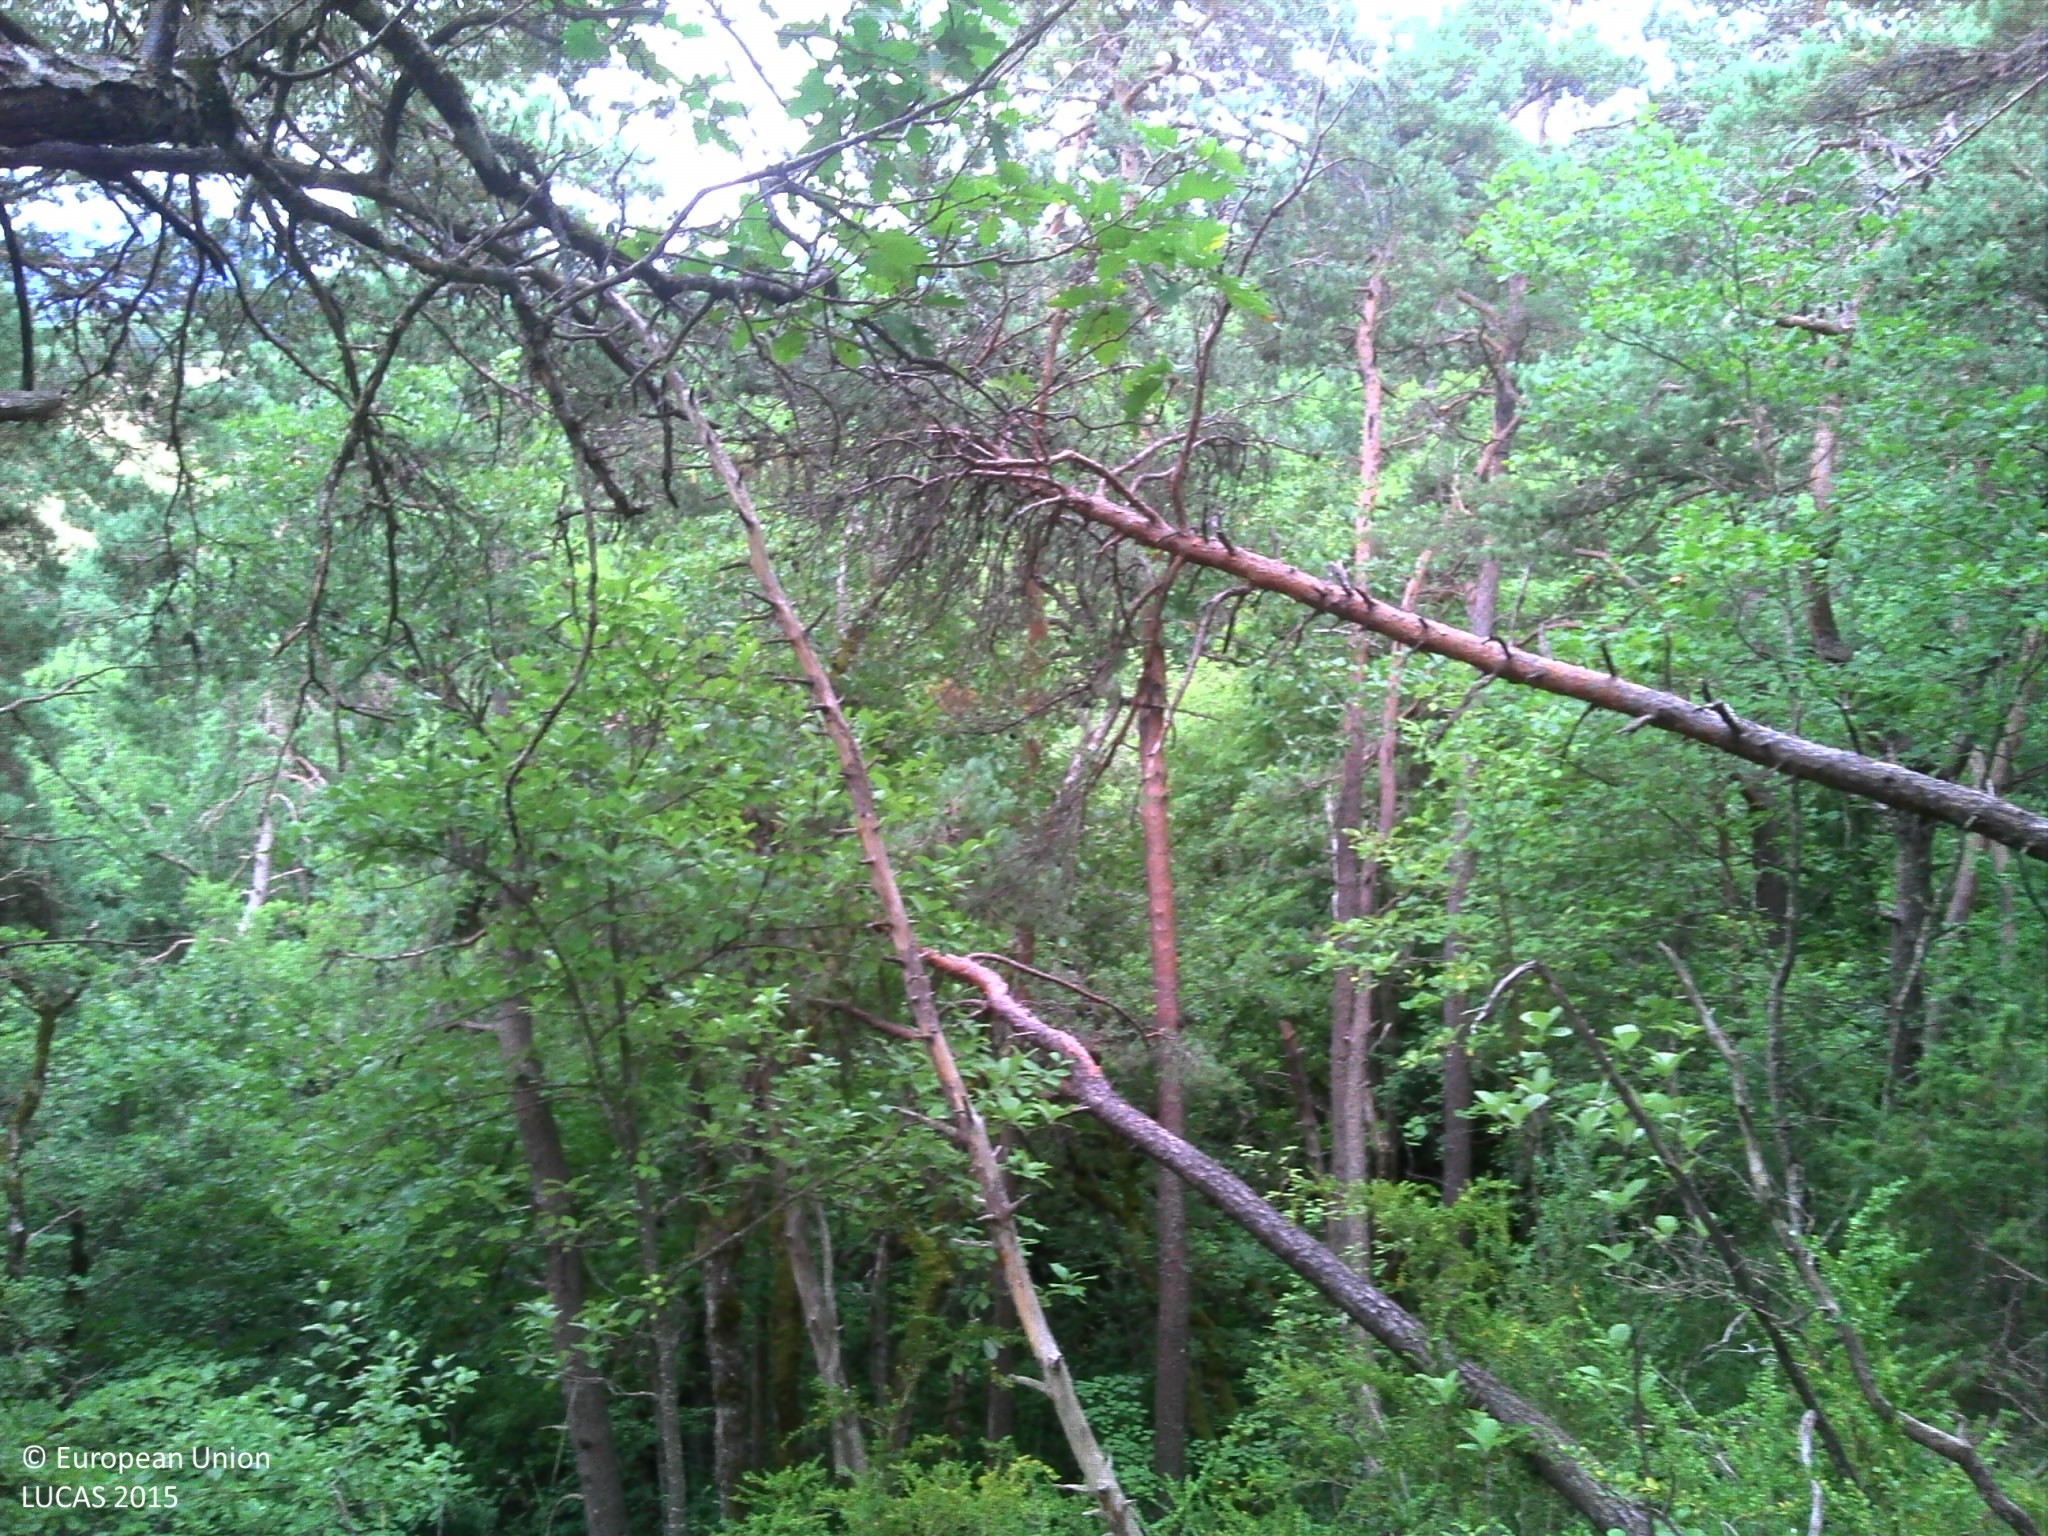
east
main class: Woodland
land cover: Other coniferous woodland
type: alpine coniferous forest
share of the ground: > 75 %
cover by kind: coniferous forest trees 75 %, broadleaved forest trees 20 %, herbaceous plants 5 %
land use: Semi-natural and natural areas not in use
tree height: > 5 m
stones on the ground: < 10 %
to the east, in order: Other coniferous woodland; Grassland without tree/shrub cover; Other coniferous woodland
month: July
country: FR
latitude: 44.8199
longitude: 5.6685
